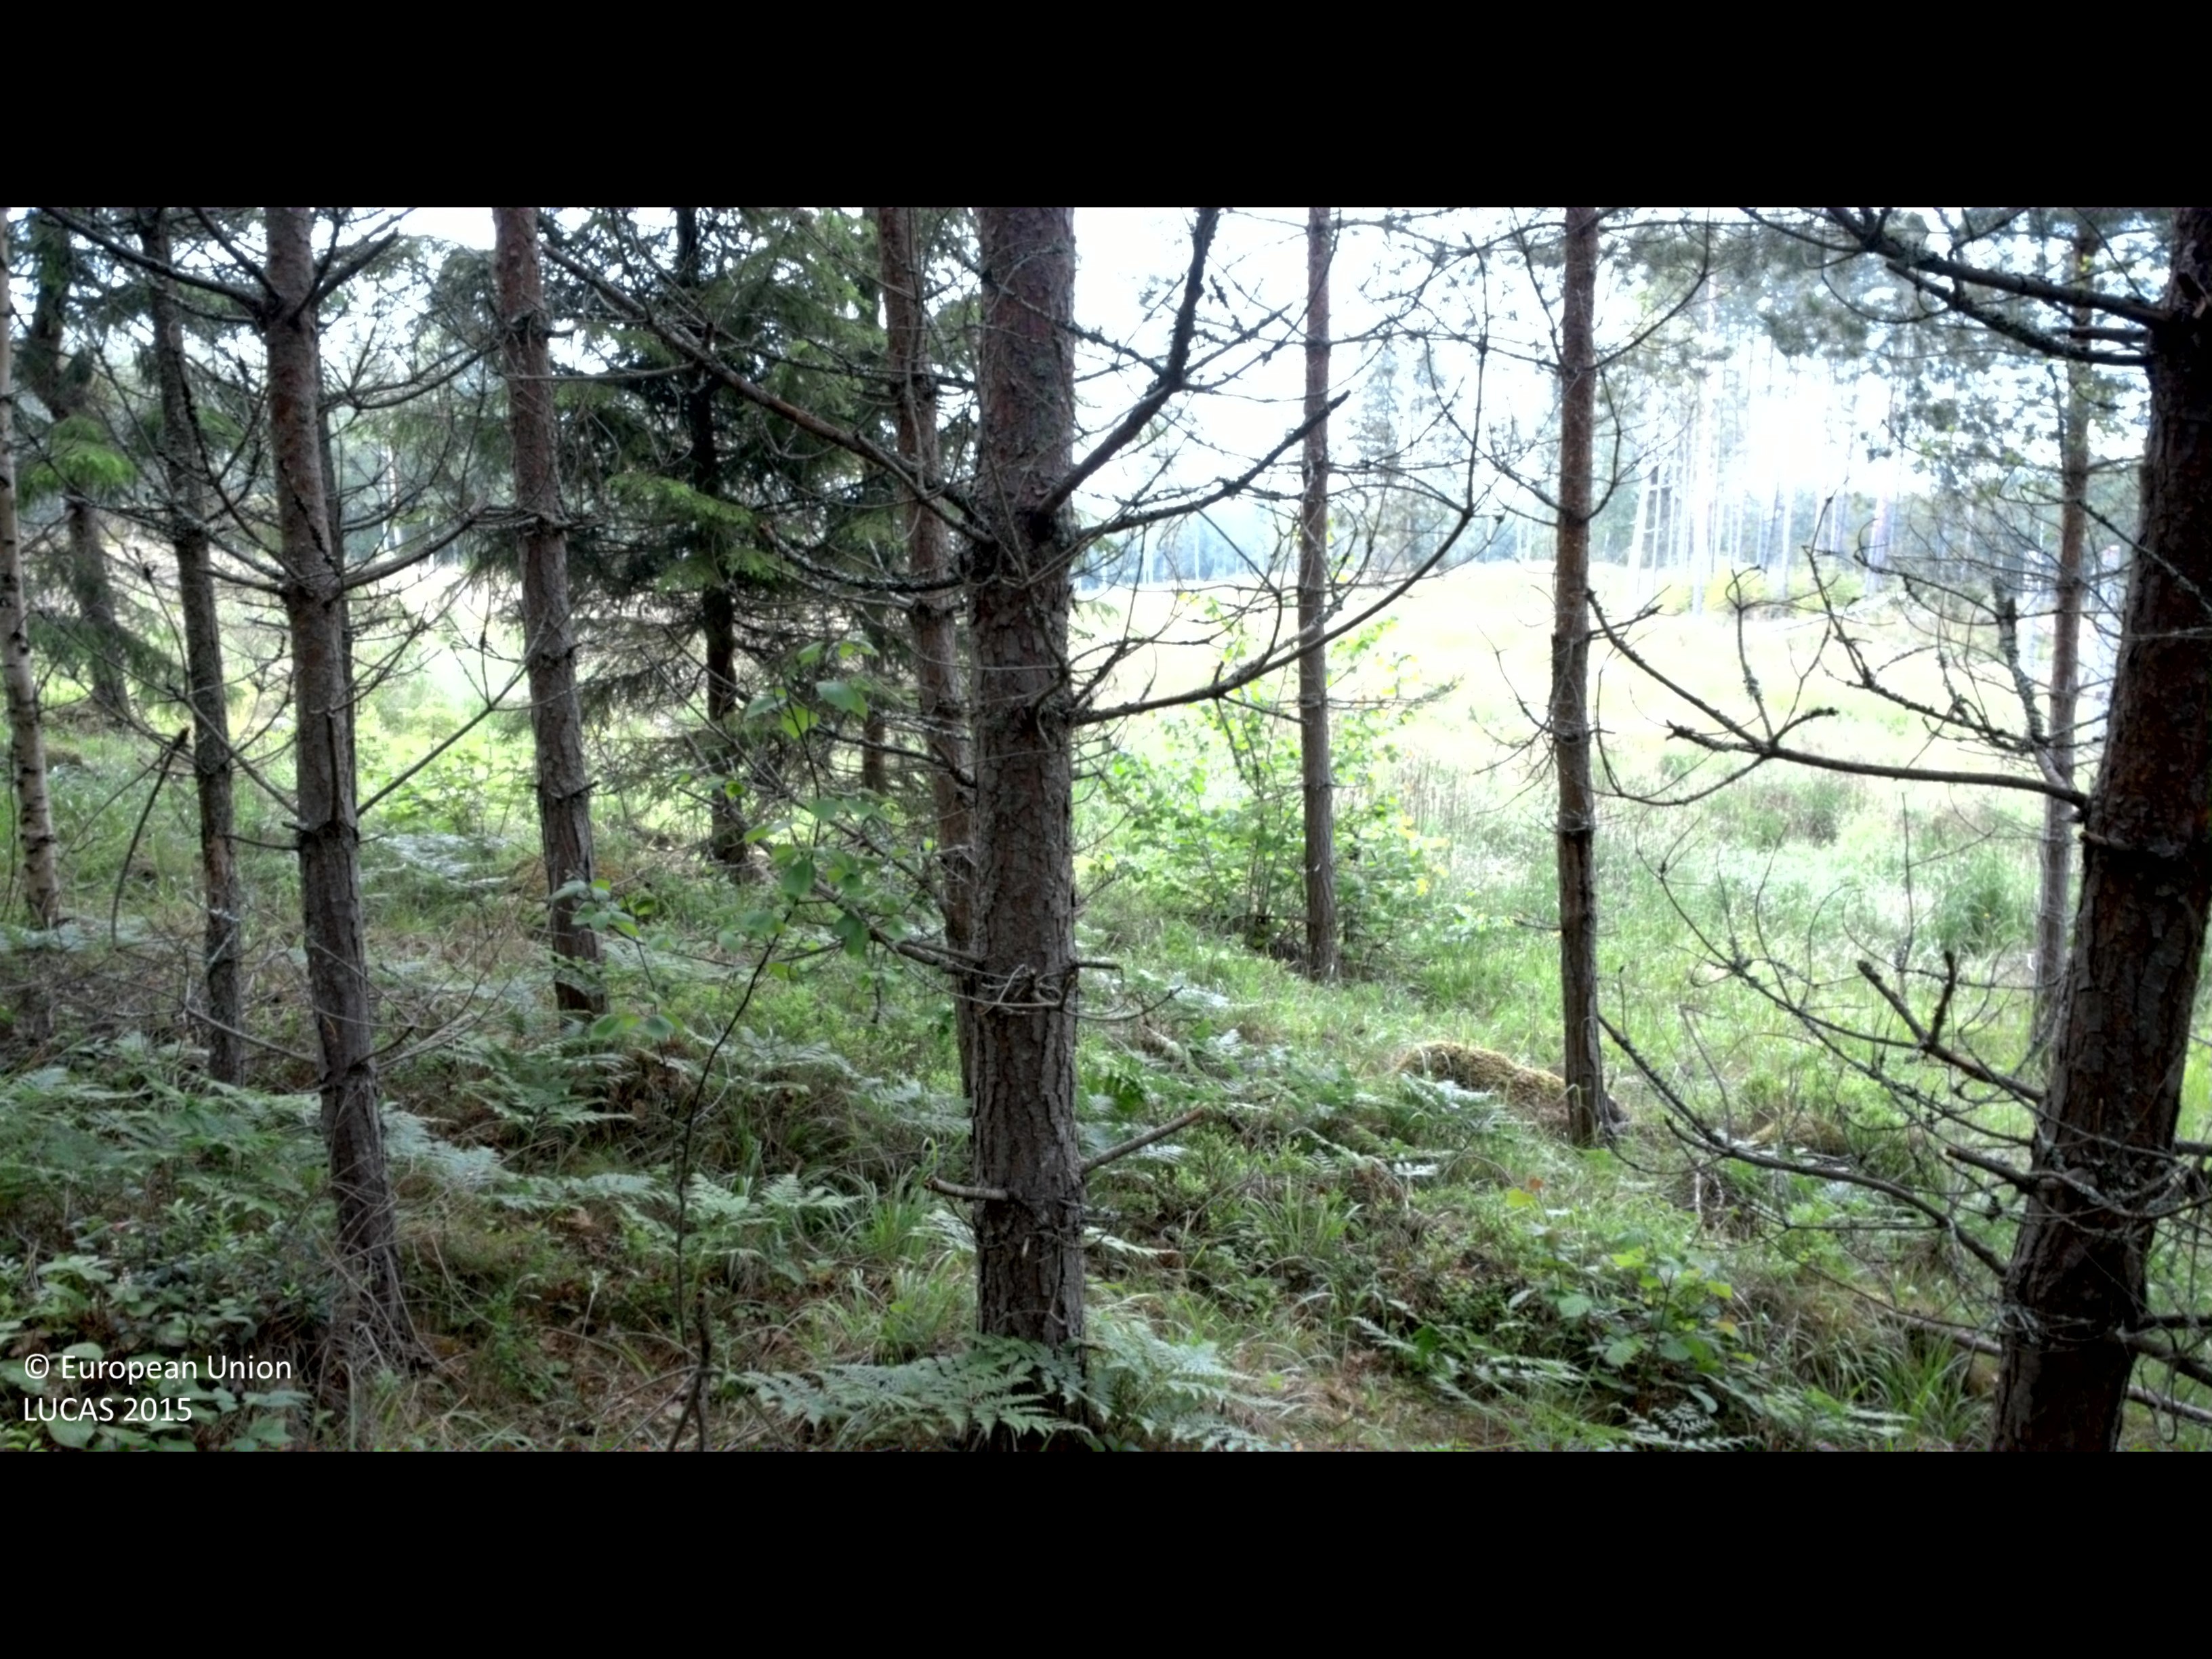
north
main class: Woodland
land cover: Pine dominated coniferous woodland
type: boreal forest
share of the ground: > 75 %
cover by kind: coniferous forest trees 65 %, broadleaved forest trees 15 %, shrubs 15 %, herbaceous plants 5 %
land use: Forestry
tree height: > 5 m
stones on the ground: 25 - 50 %
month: June
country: SE
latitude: 58.0024
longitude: 16.2406
